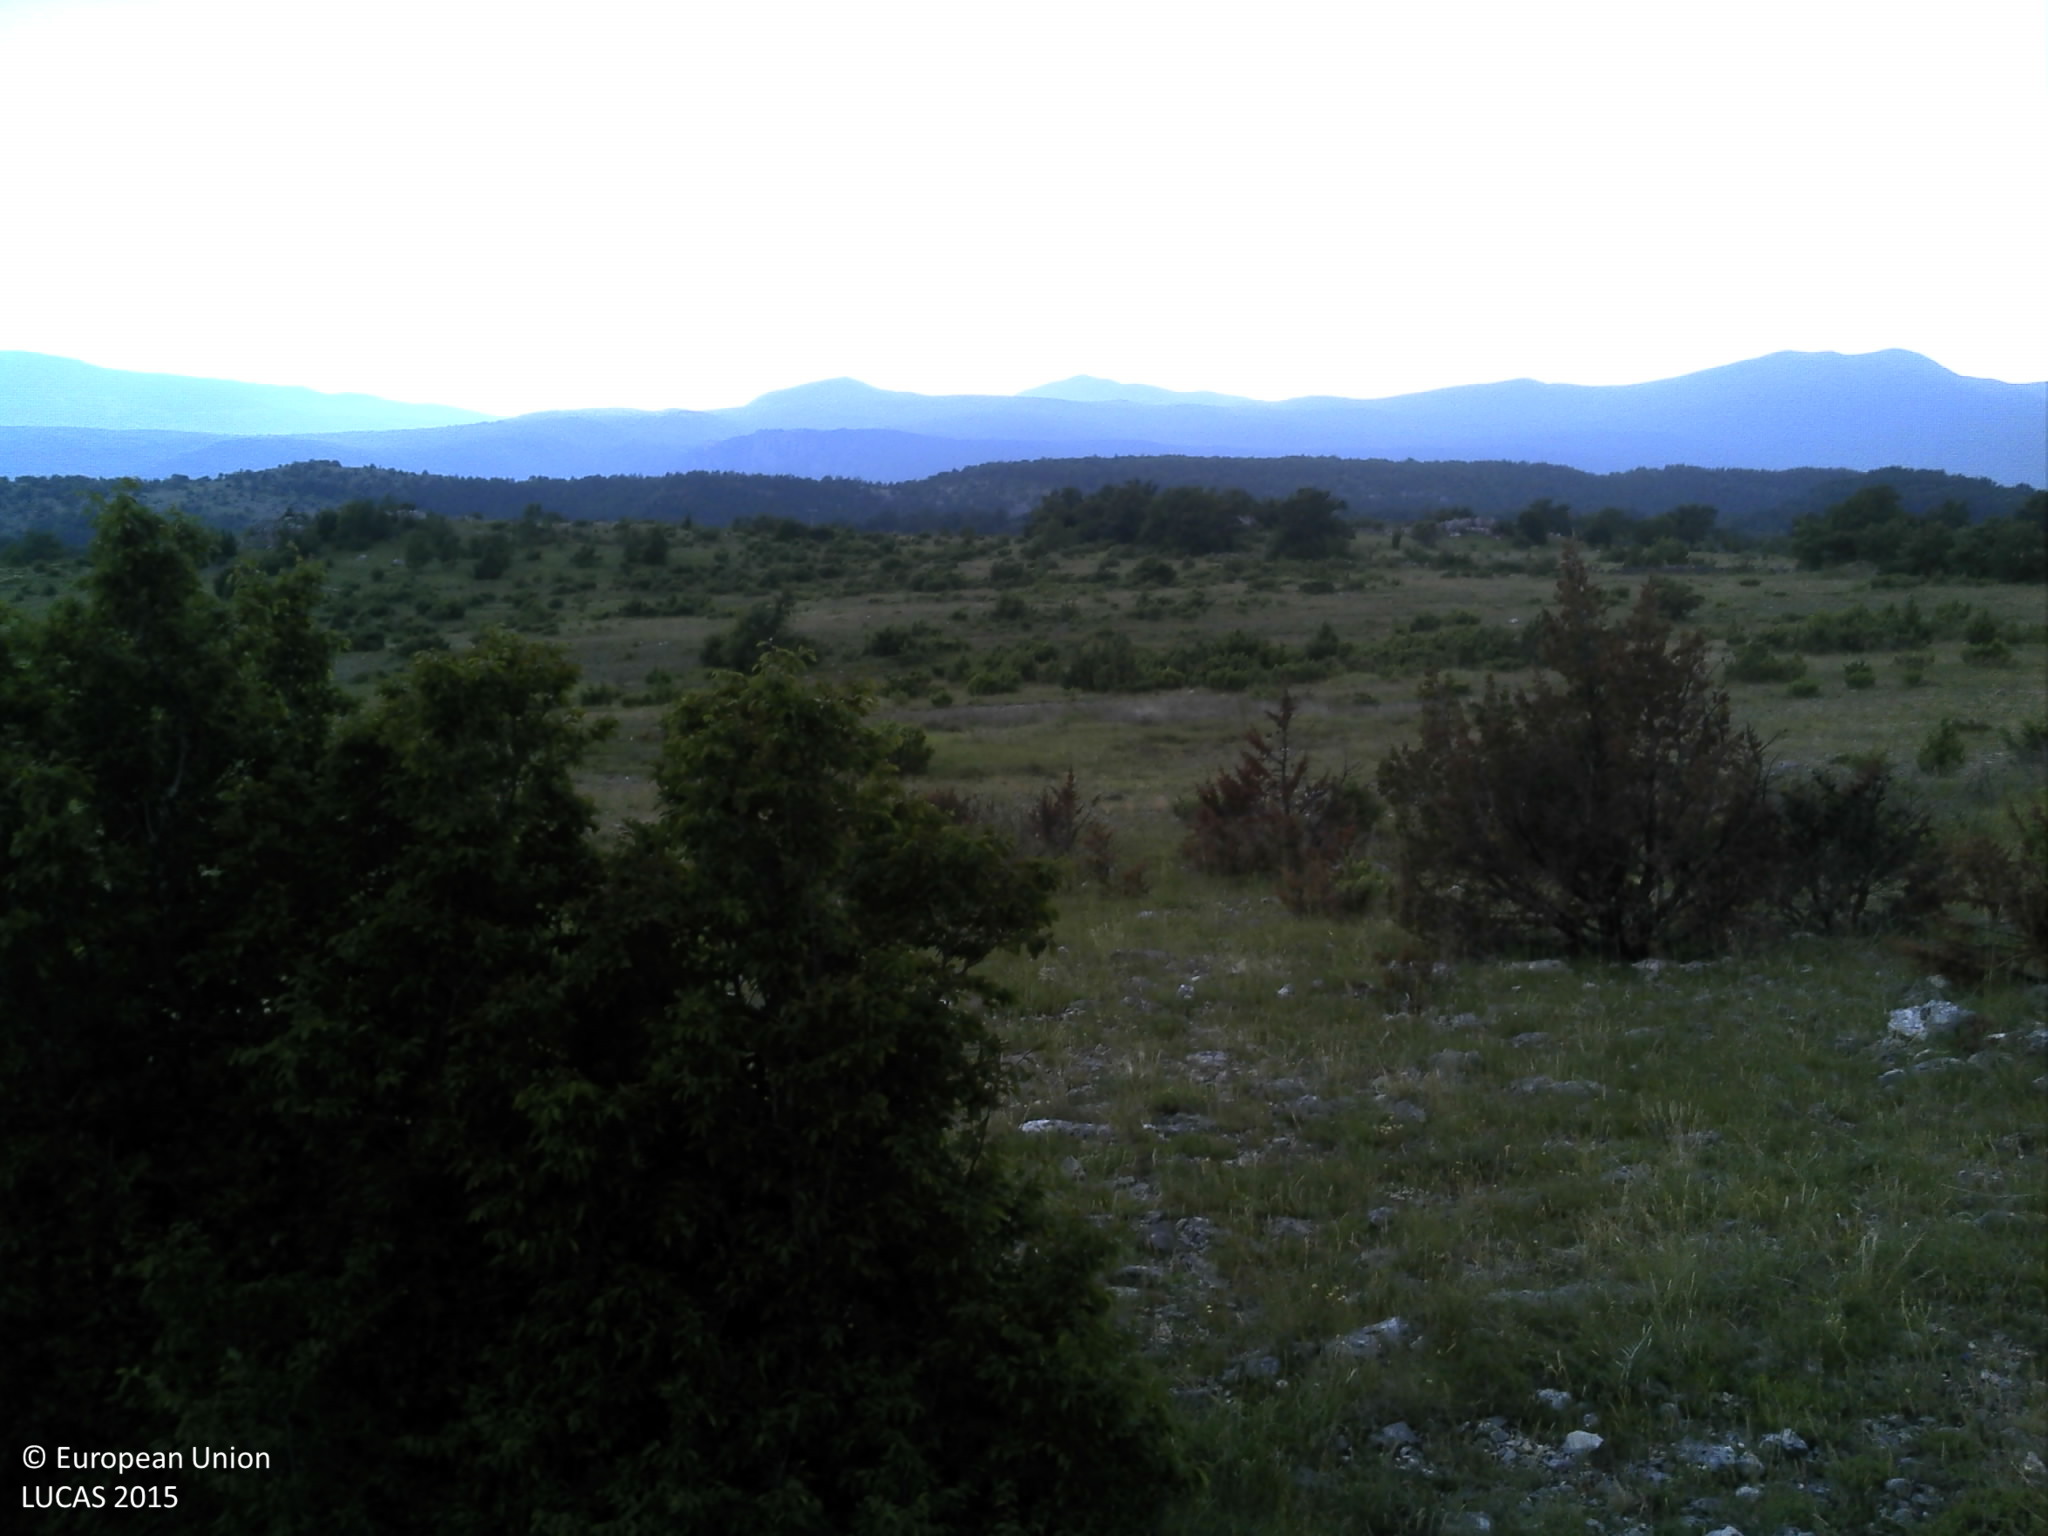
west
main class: Shrubland
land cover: Shrubland with sparse tree cover
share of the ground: 10 - 25 %
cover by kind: herbaceous plants 45 %, shrubs 20 %, unconsolidated bare surface 20 %, consolidated bare surface 10 %, broadleaved forest trees 5 %
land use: Agriculture (excluding fallow land and kitchen gardens)
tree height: < 5 m
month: June
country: HR
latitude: 43.9323
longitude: 16.4575
